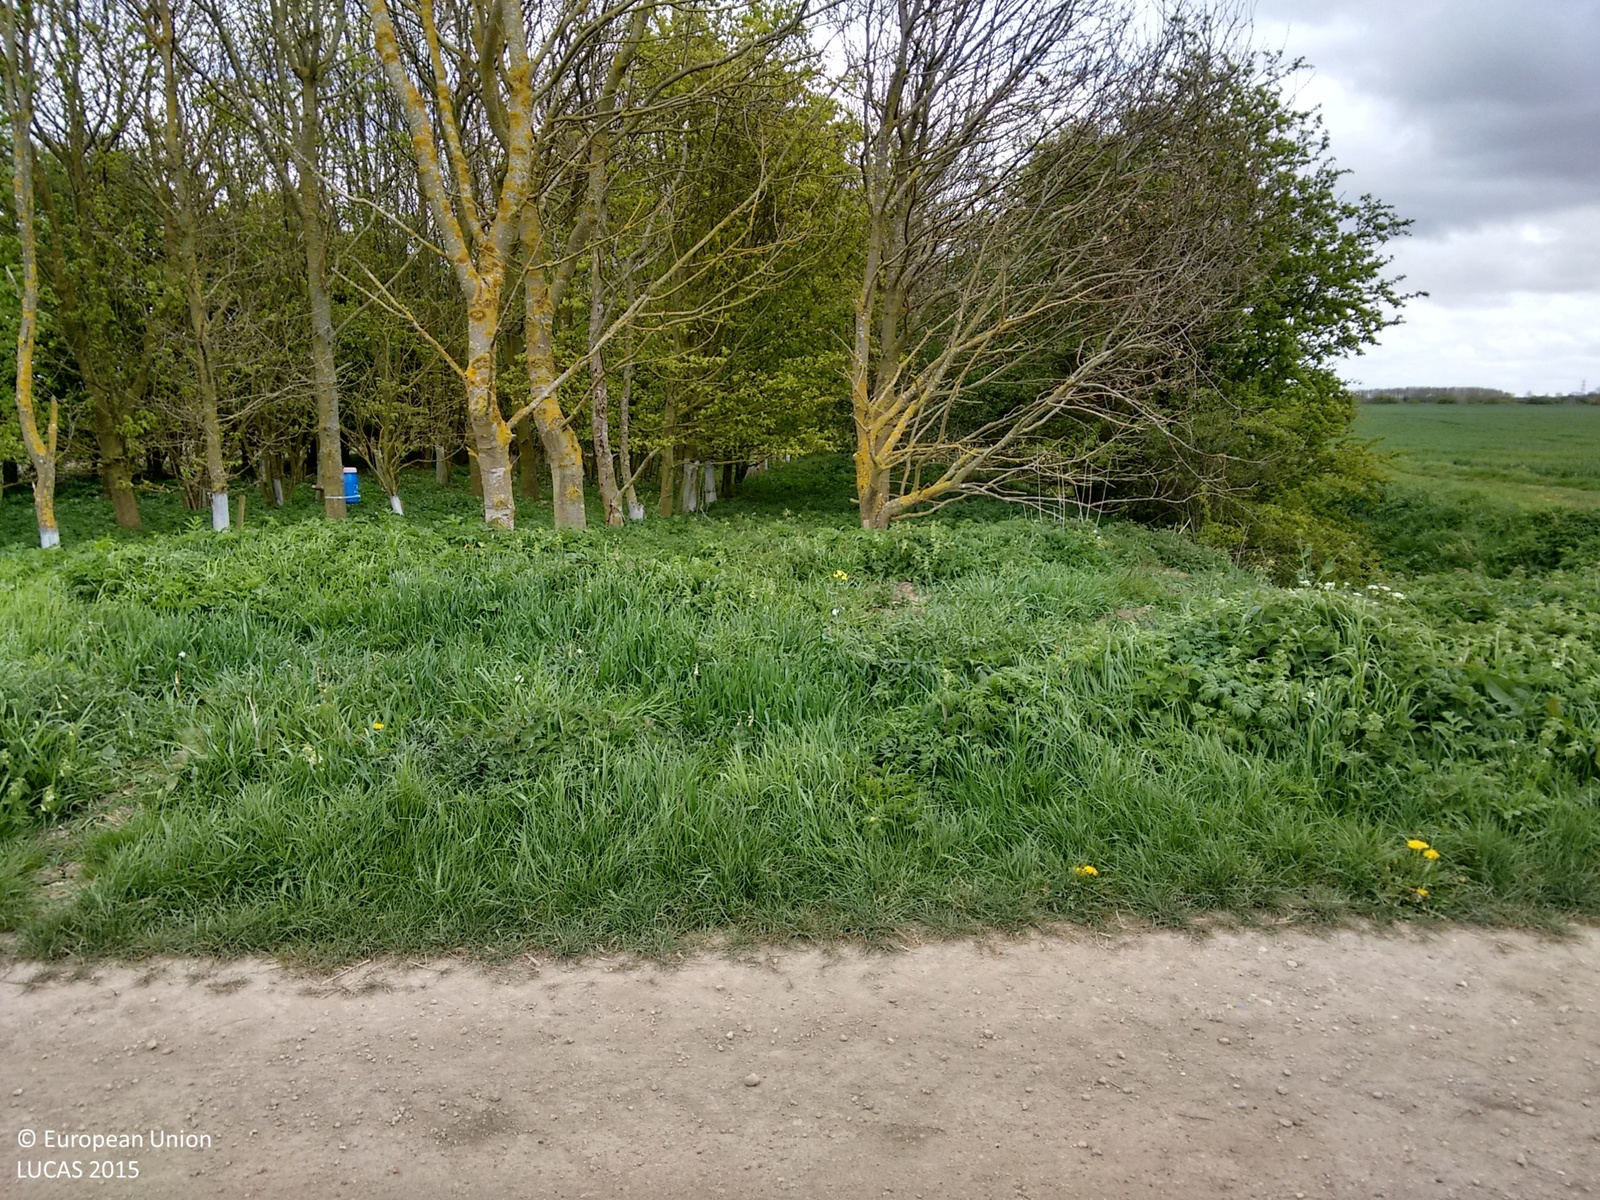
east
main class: Cropland
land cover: Rape and turnip rape
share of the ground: > 75 %
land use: Agriculture (excluding fallow land and kitchen gardens)
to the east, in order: Rape and turnip rape; Grass margins; Tracks; Grass margins; Other bare soil; Grassland without tree/shrub cover; Inland fresh water bodies; Grassland without tree/shrub cover; Other bare soil
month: May
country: GB
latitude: 53.0632
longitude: 0.0449
